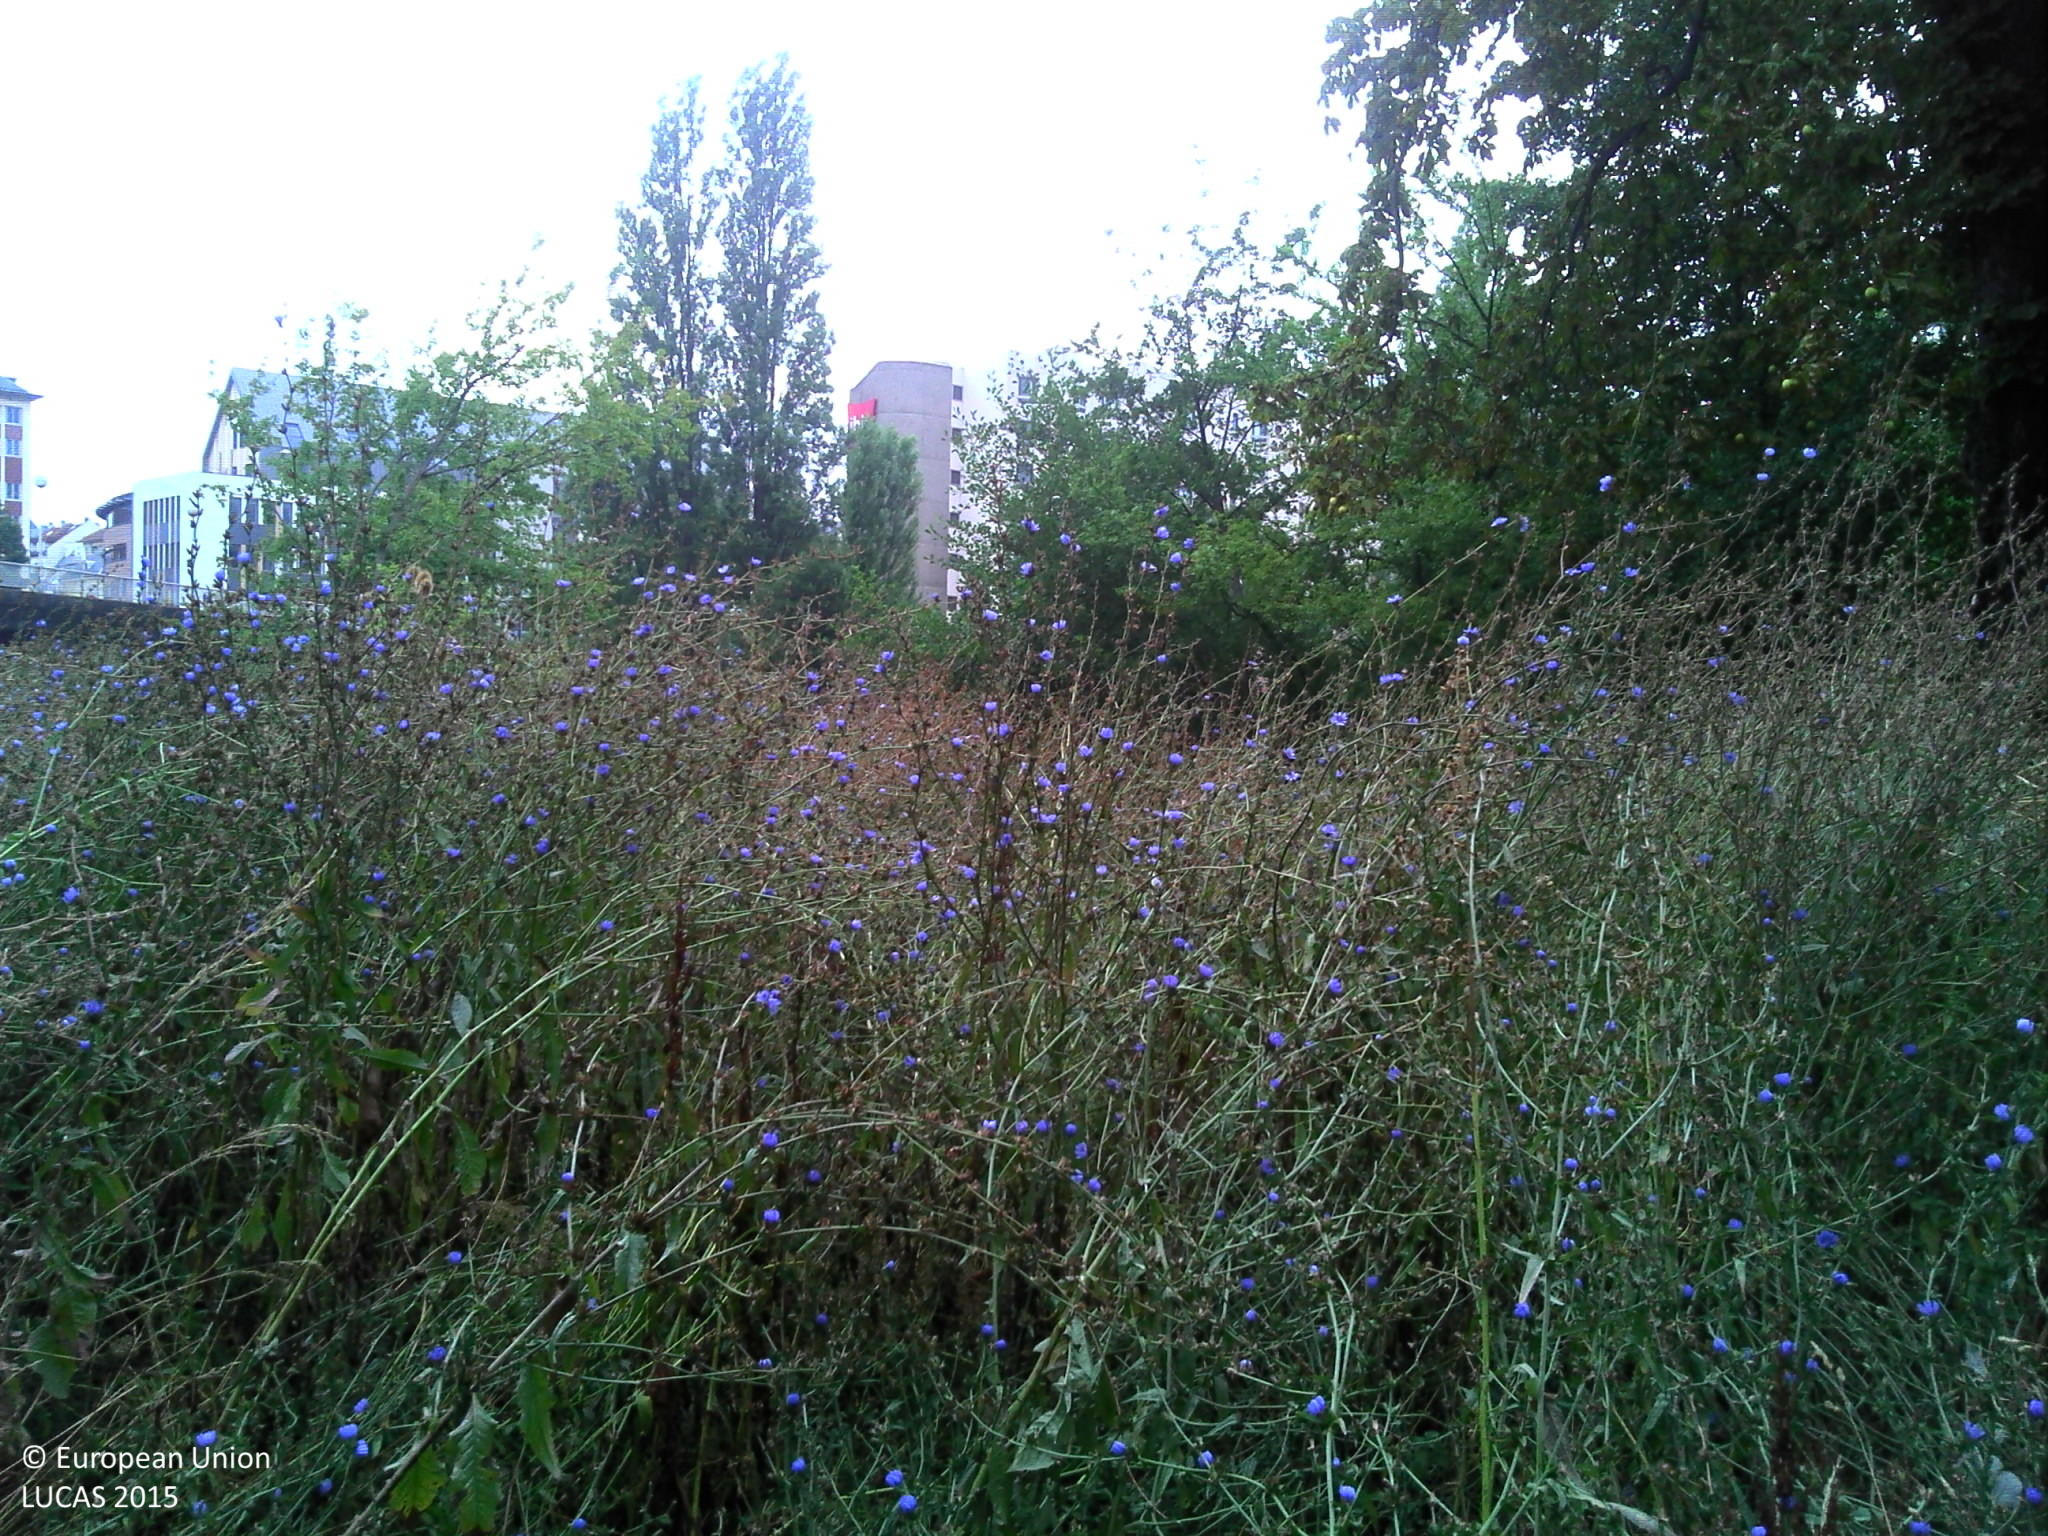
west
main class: Grassland
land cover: Spontaneously vegetated surfaces
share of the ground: > 75 %
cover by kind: herbaceous plants 100 %
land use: Community services
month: August
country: FR
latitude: 48.5784
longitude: 7.7372
